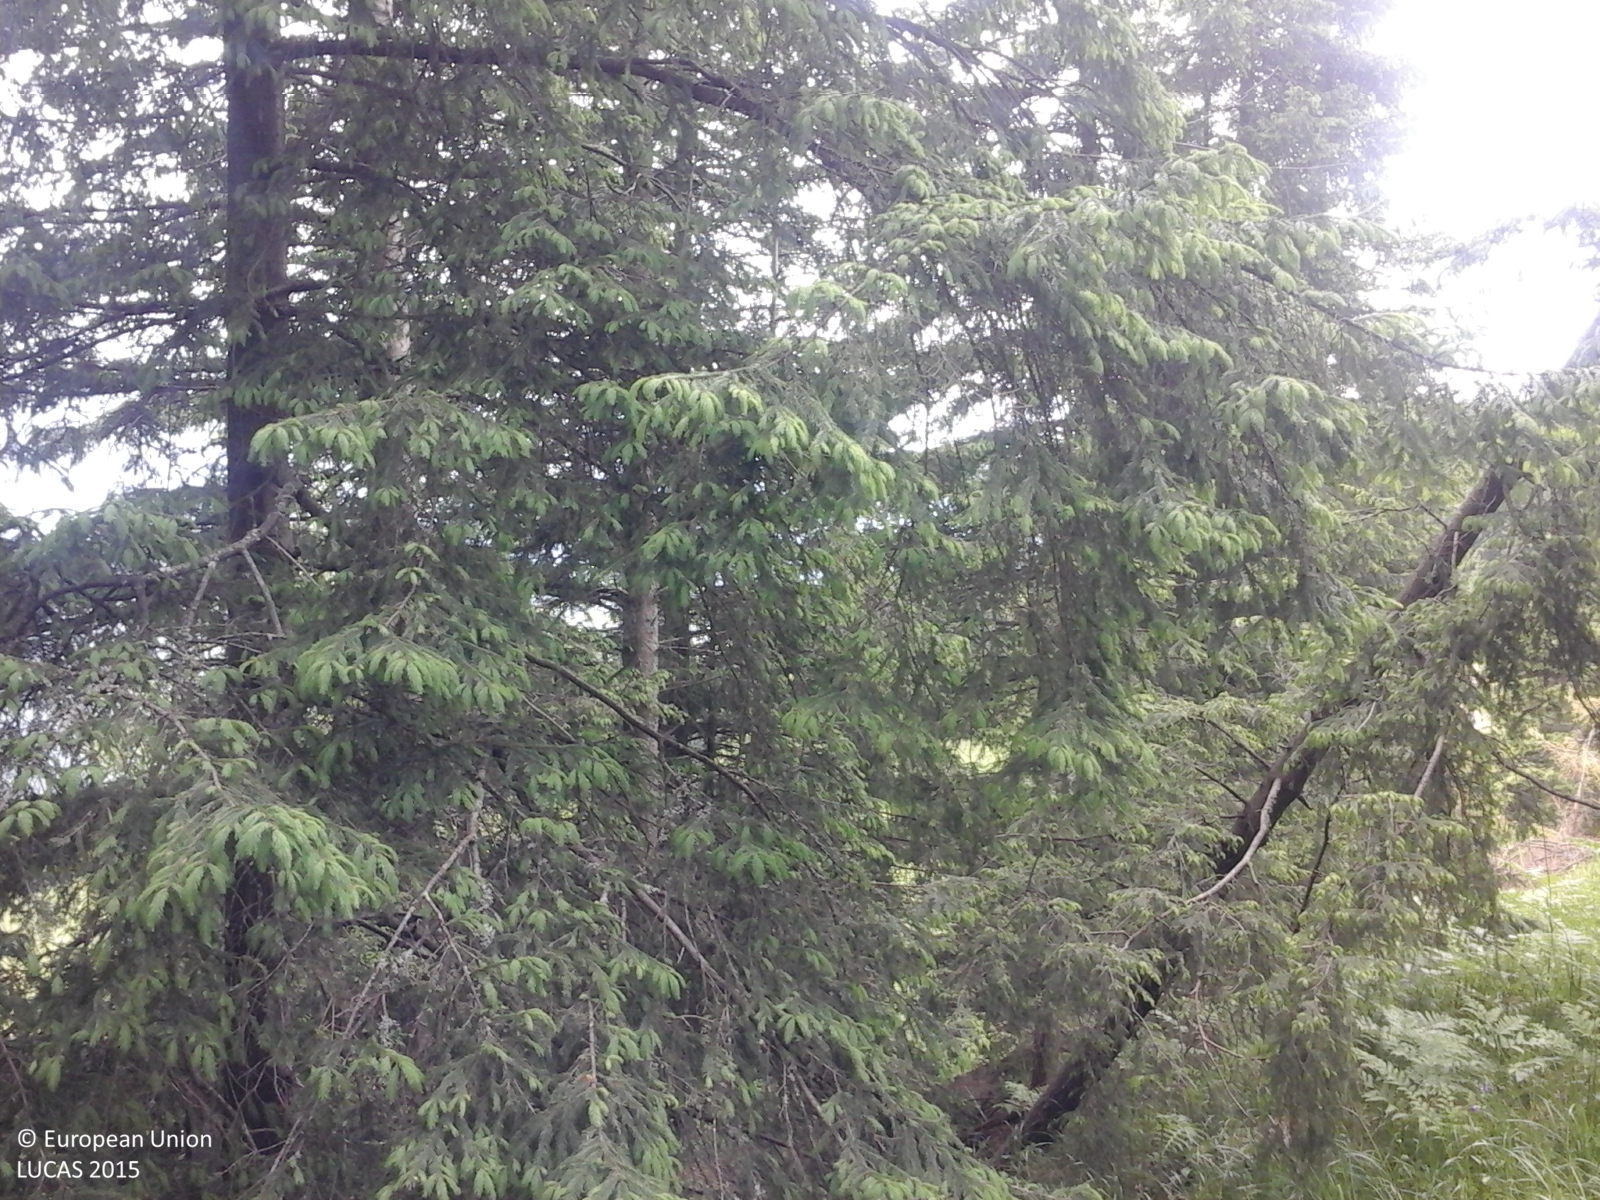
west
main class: Woodland
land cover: Spruce dominated coniferous woodland
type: alpine coniferous forest
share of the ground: > 75 %
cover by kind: coniferous forest trees 90 %, herbaceous plants 10 %
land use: Forestry
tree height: > 5 m
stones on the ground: 10 - 25 %
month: June
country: RO
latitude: 47.3072
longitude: 25.7146
